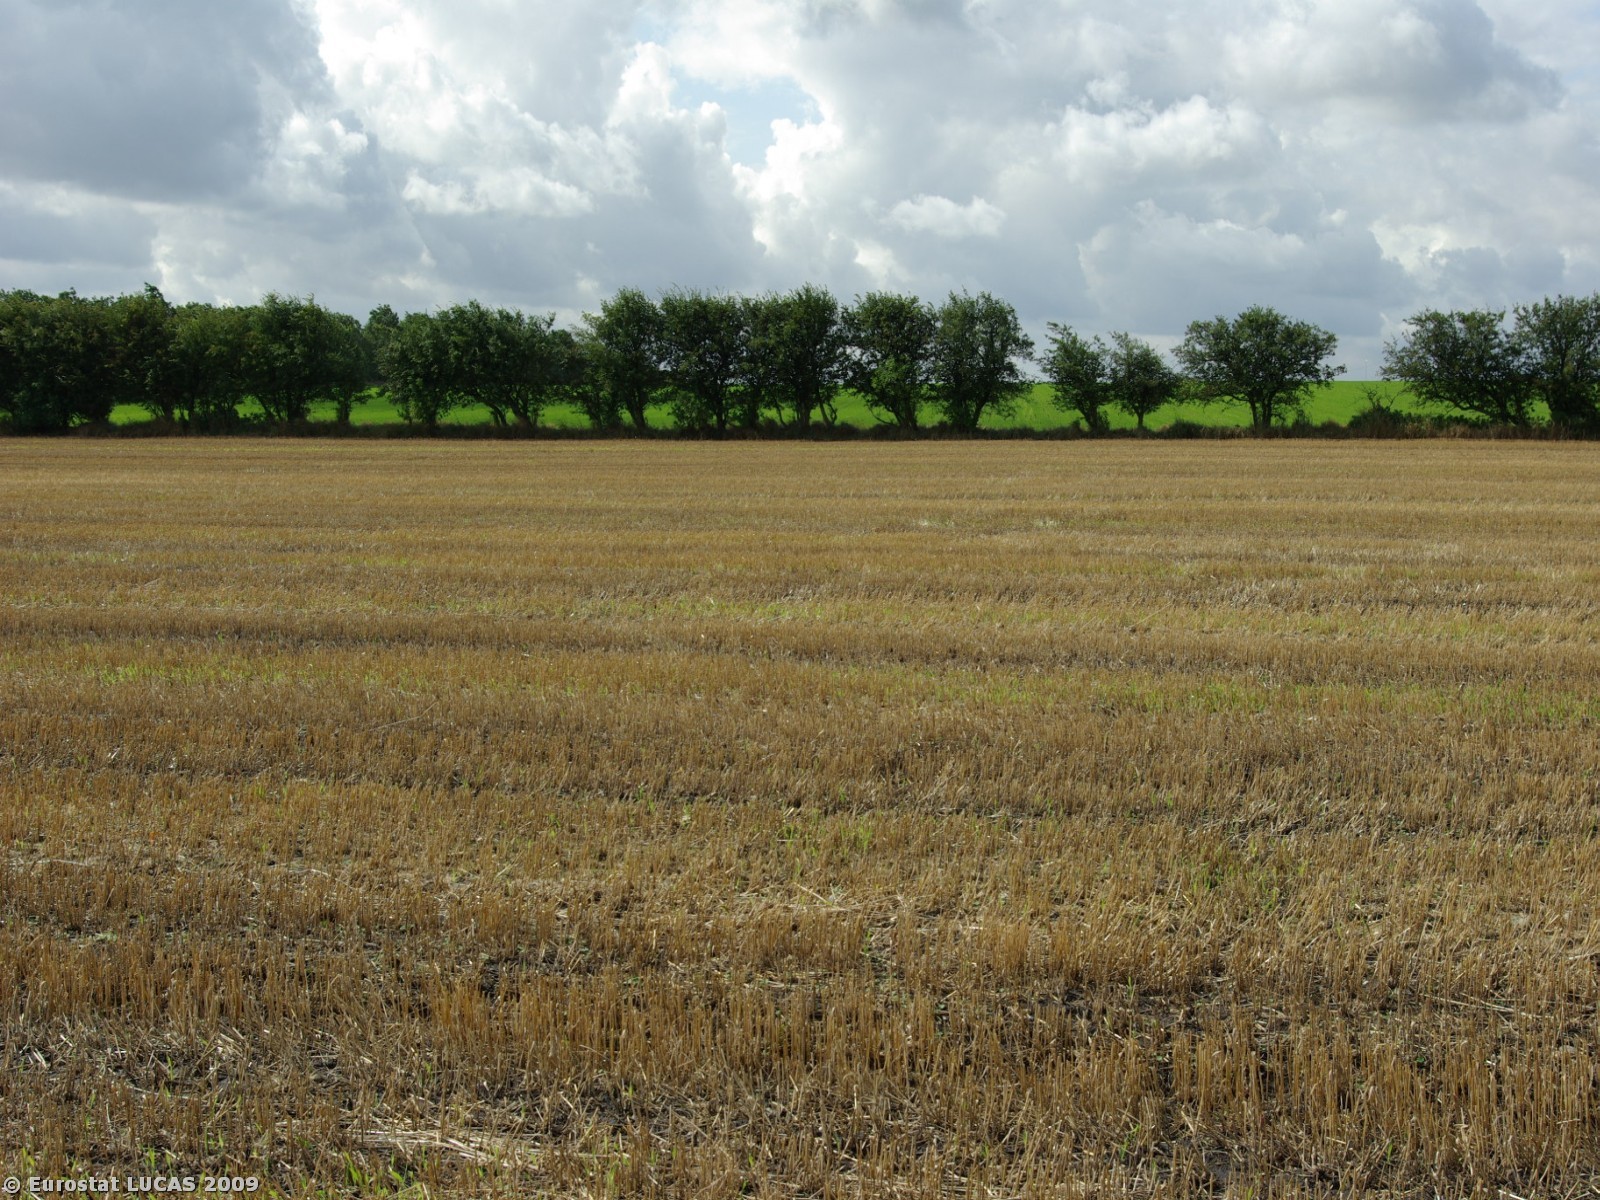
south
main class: Cropland
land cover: Barley
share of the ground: < 10 %
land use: Agriculture (excluding fallow land and kitchen gardens)
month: July
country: DK
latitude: 55.1433
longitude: 9.2946
